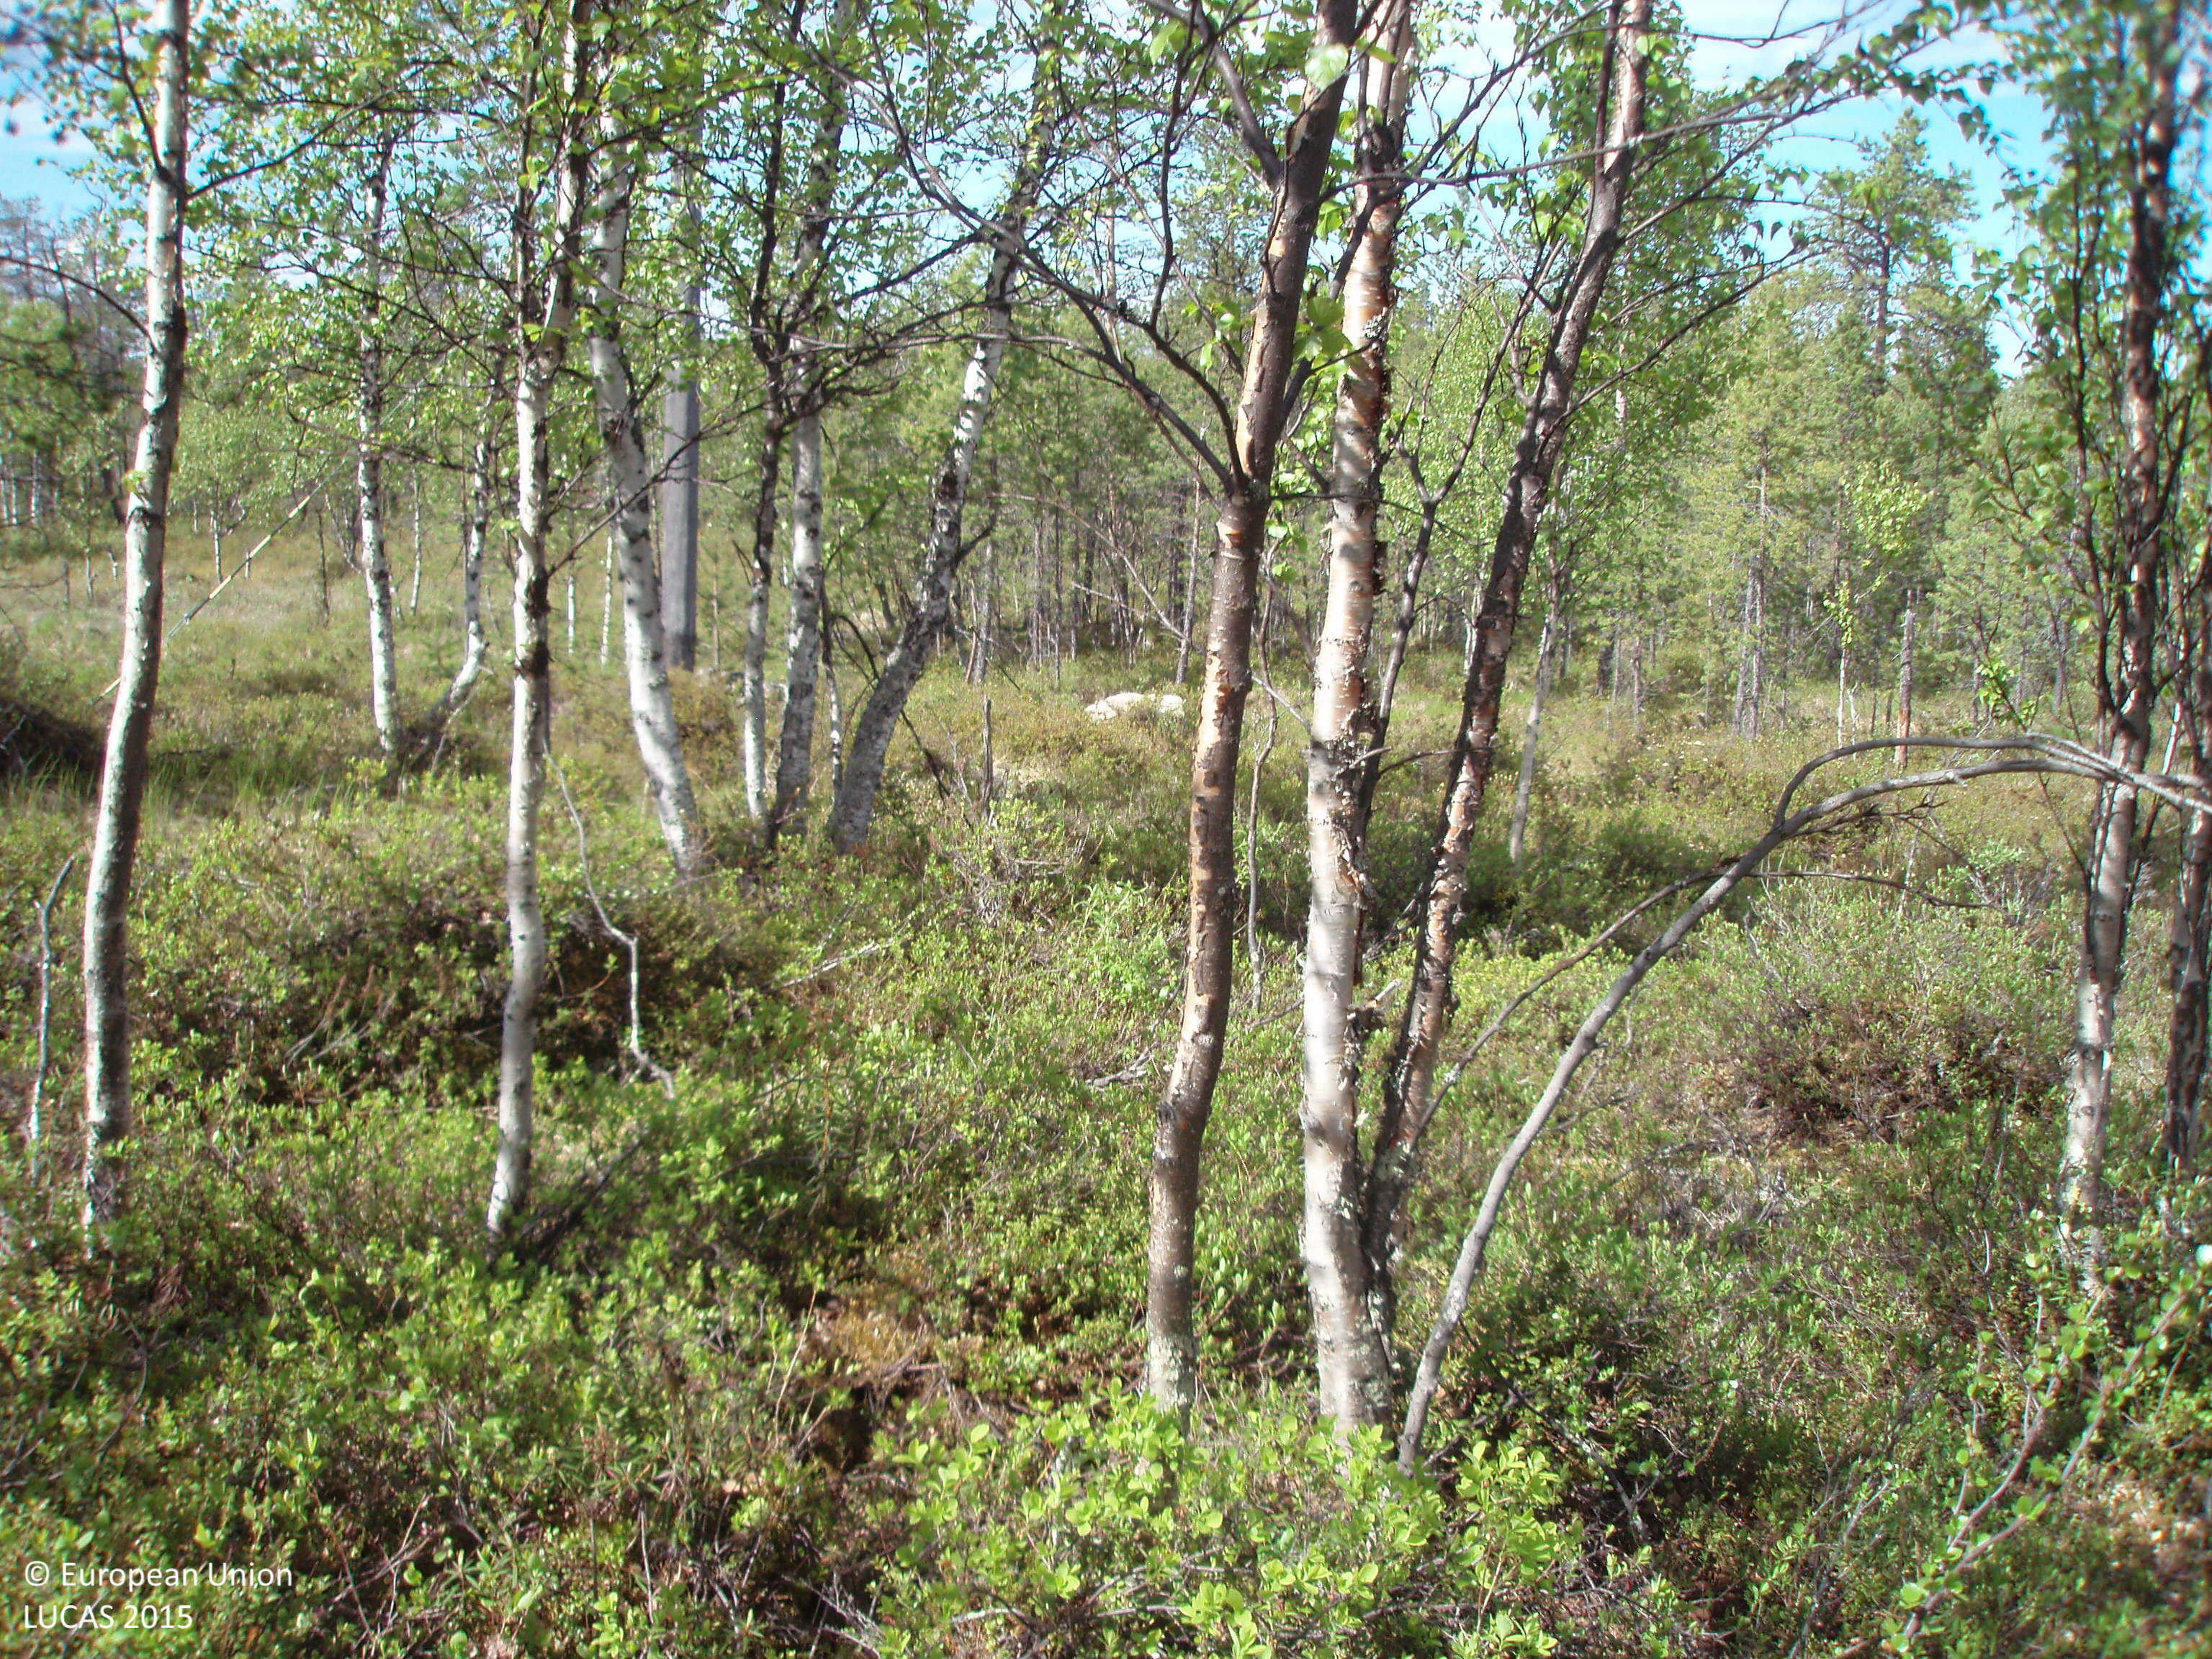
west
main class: Woodland
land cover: Pine dominated mixed woodland
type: boreal forest
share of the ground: 50 - 75 %
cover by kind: broadleaved forest trees 40 %, coniferous forest trees 30 %, shrubs 20 %, herbaceous plants 5 %, lichens and mosses 5 %
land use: Forestry
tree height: > 5 m
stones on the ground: 25 - 50 %
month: June
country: FI
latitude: 68.7707
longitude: 28.0821
